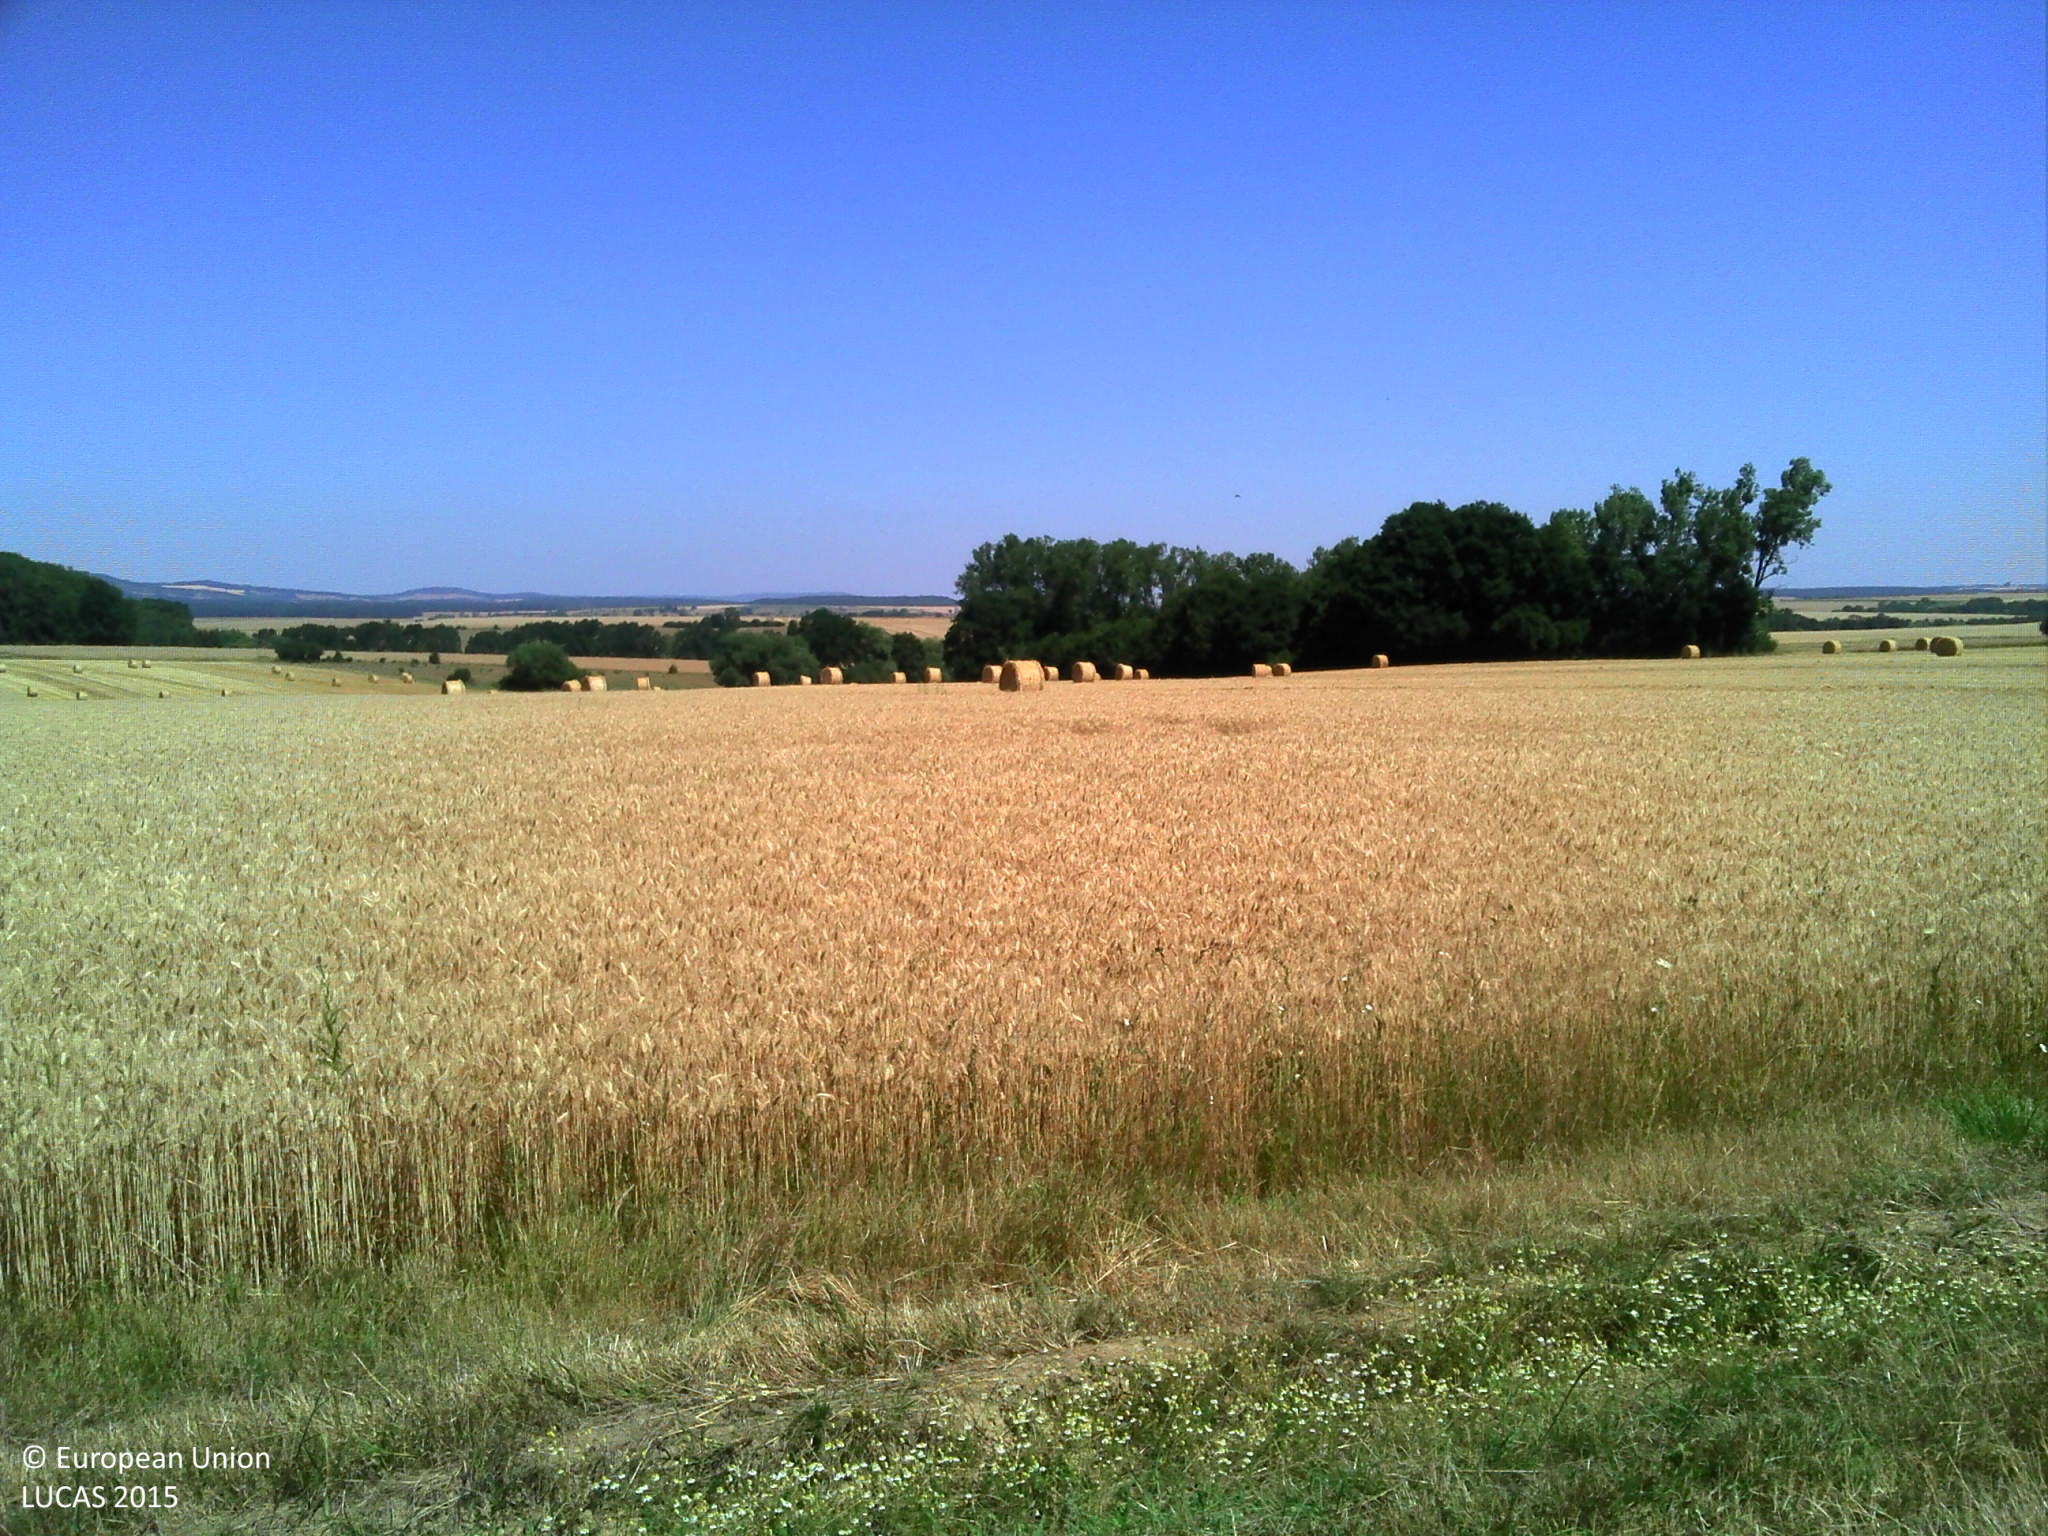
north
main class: Cropland
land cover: Rape and turnip rape
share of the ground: > 75 %
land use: Agriculture (excluding fallow land and kitchen gardens)
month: July
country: FR
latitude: 48.9125
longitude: 6.1383
